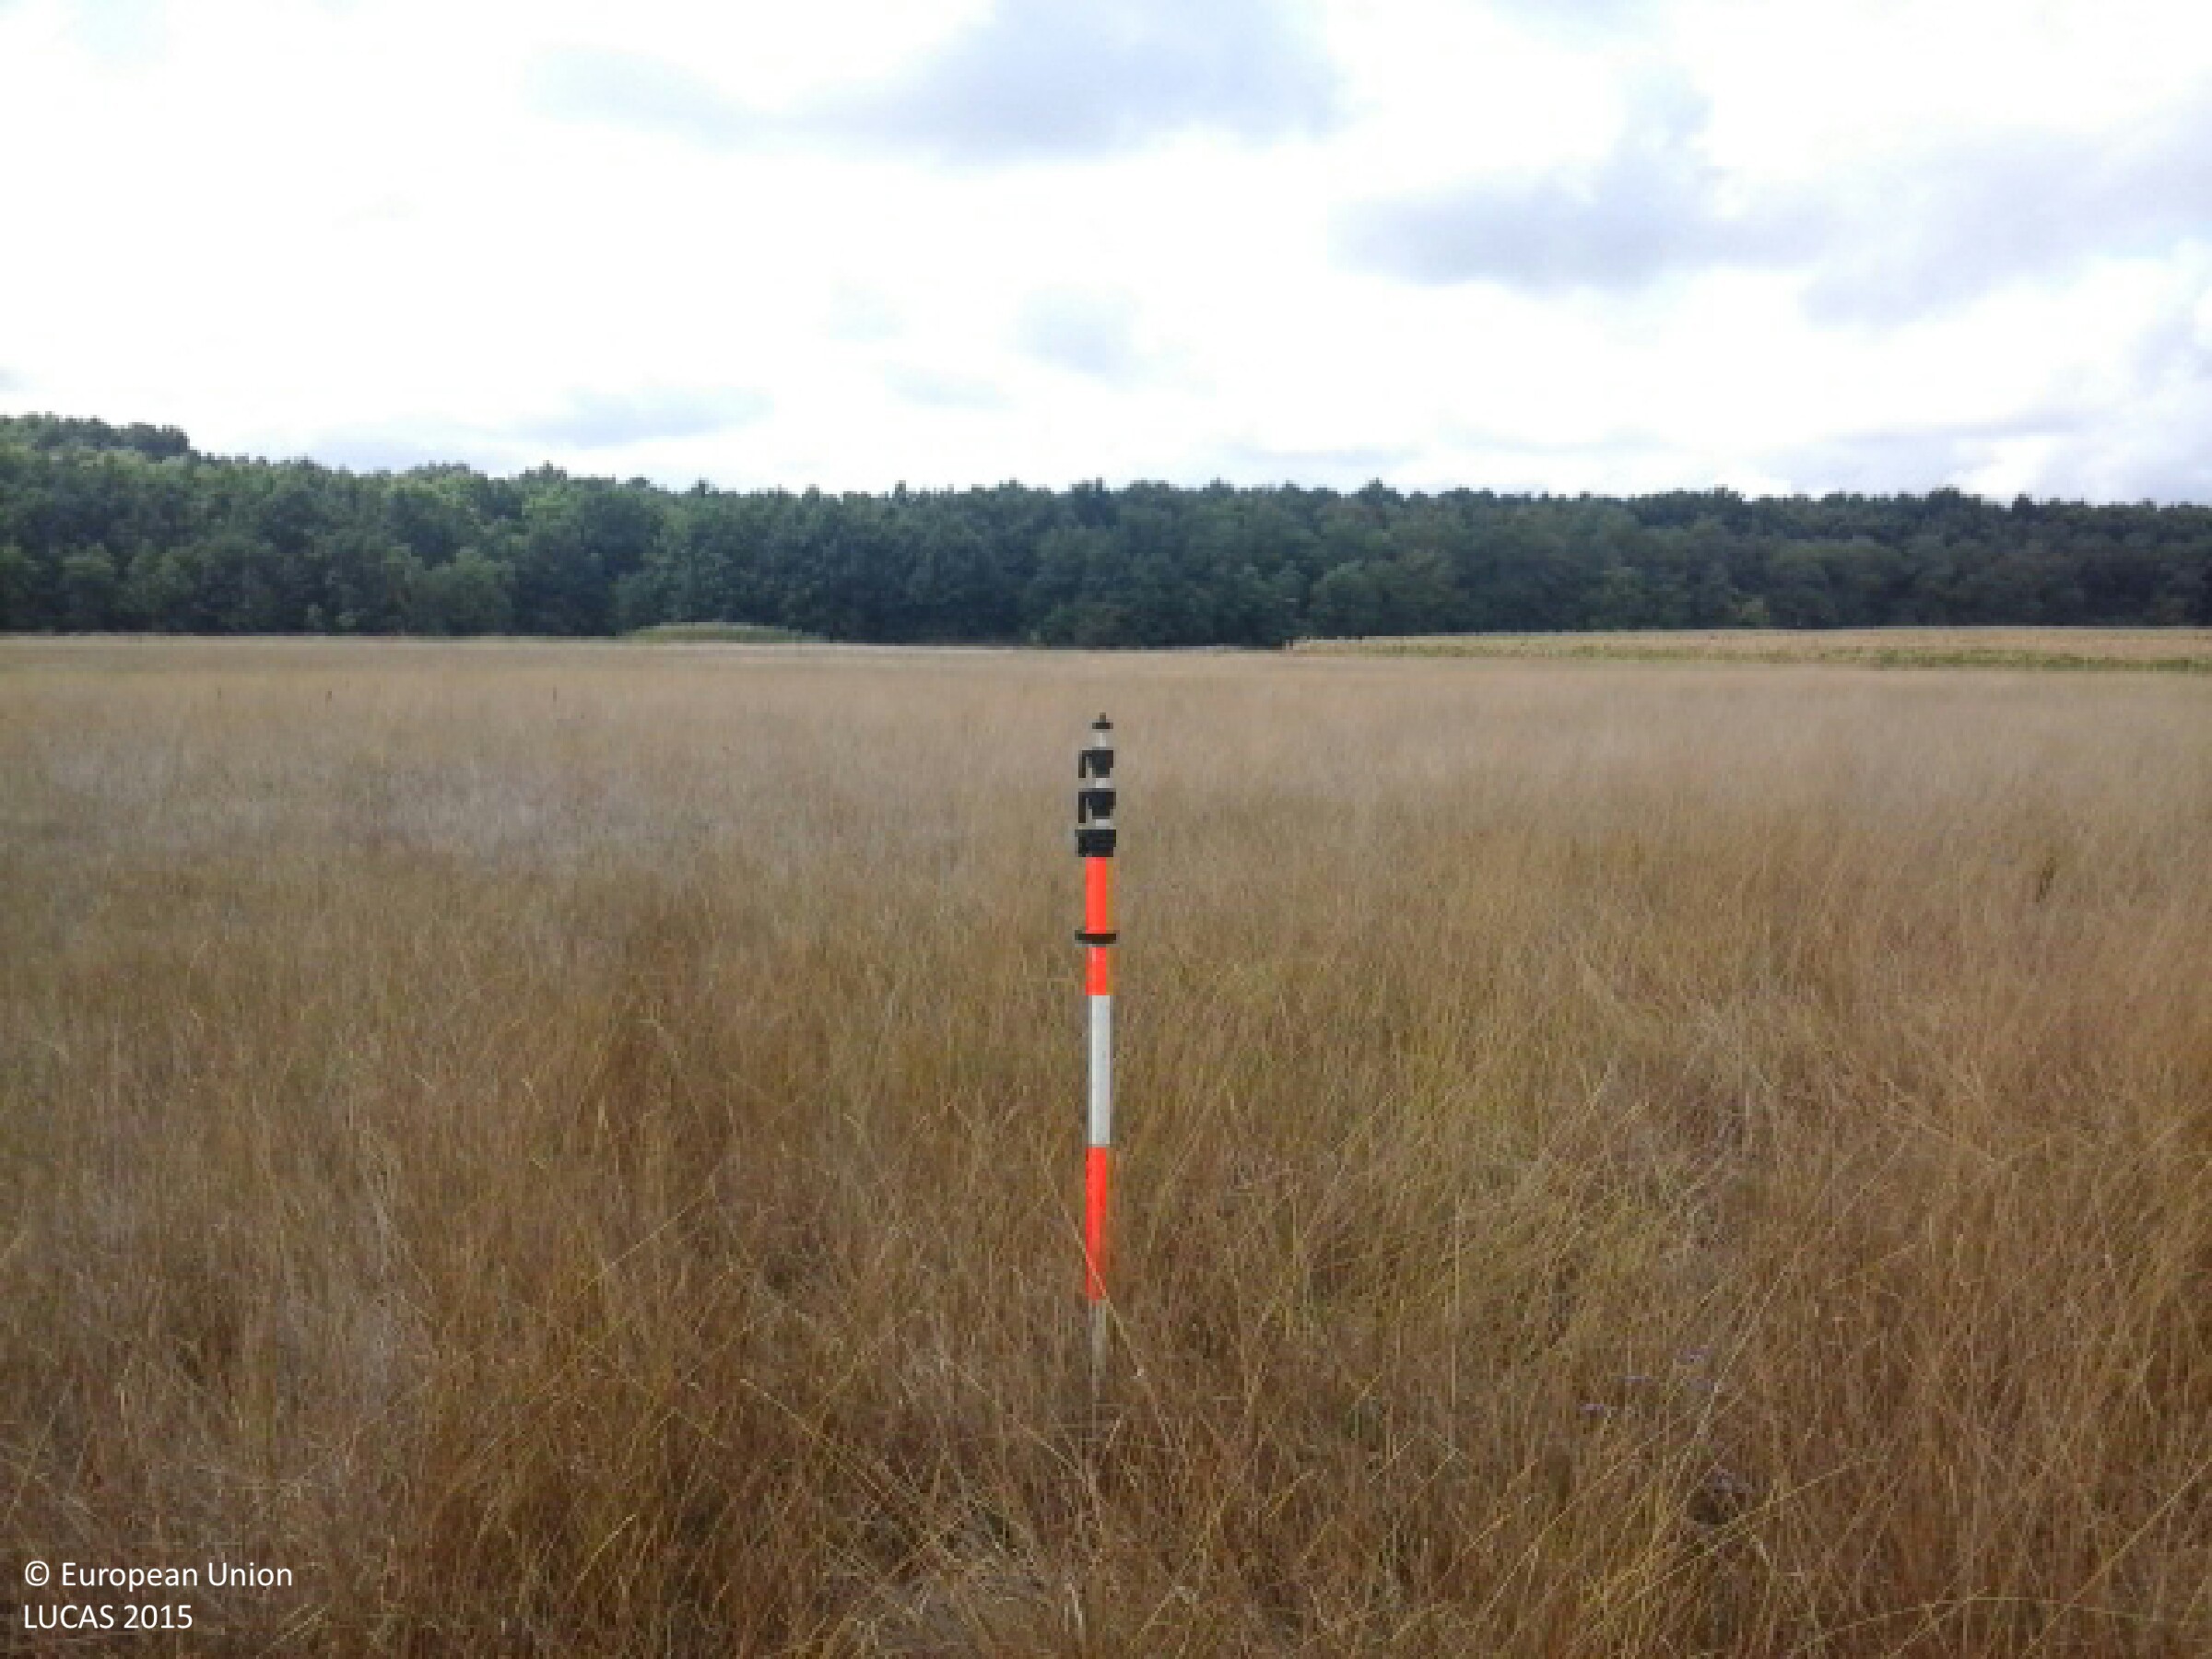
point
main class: Grassland
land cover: Grassland without tree/shrub cover
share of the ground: > 75 %
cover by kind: herbaceous plants 100 %
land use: Semi-natural and natural areas not in use
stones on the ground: < 10 %
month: August
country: HU
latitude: 47.0880
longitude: 21.5411
